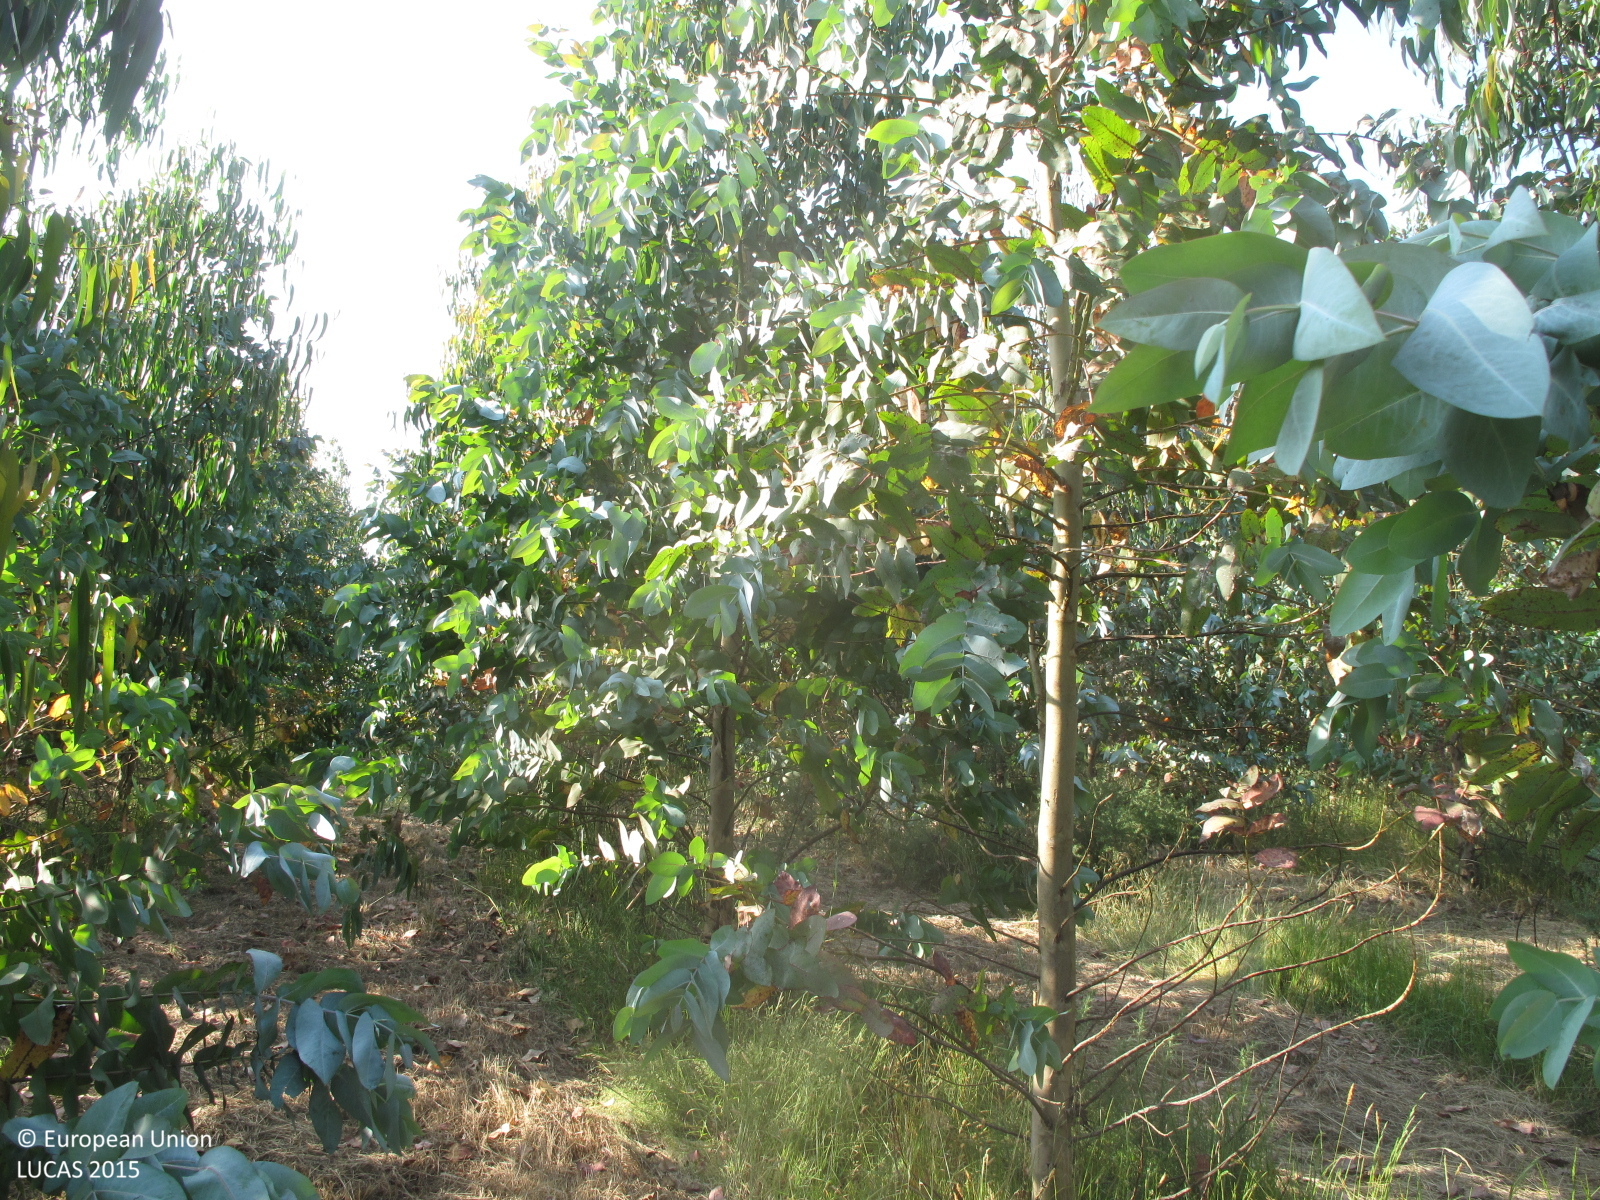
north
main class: Woodland
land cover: Broadleaved woodland
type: exotic forest
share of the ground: 50 - 75 %
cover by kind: broadleaved forest trees 50 %, herbaceous plants 50 %
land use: Forestry
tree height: < 5 m
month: June
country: ES
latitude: 43.0504
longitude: -7.9264
